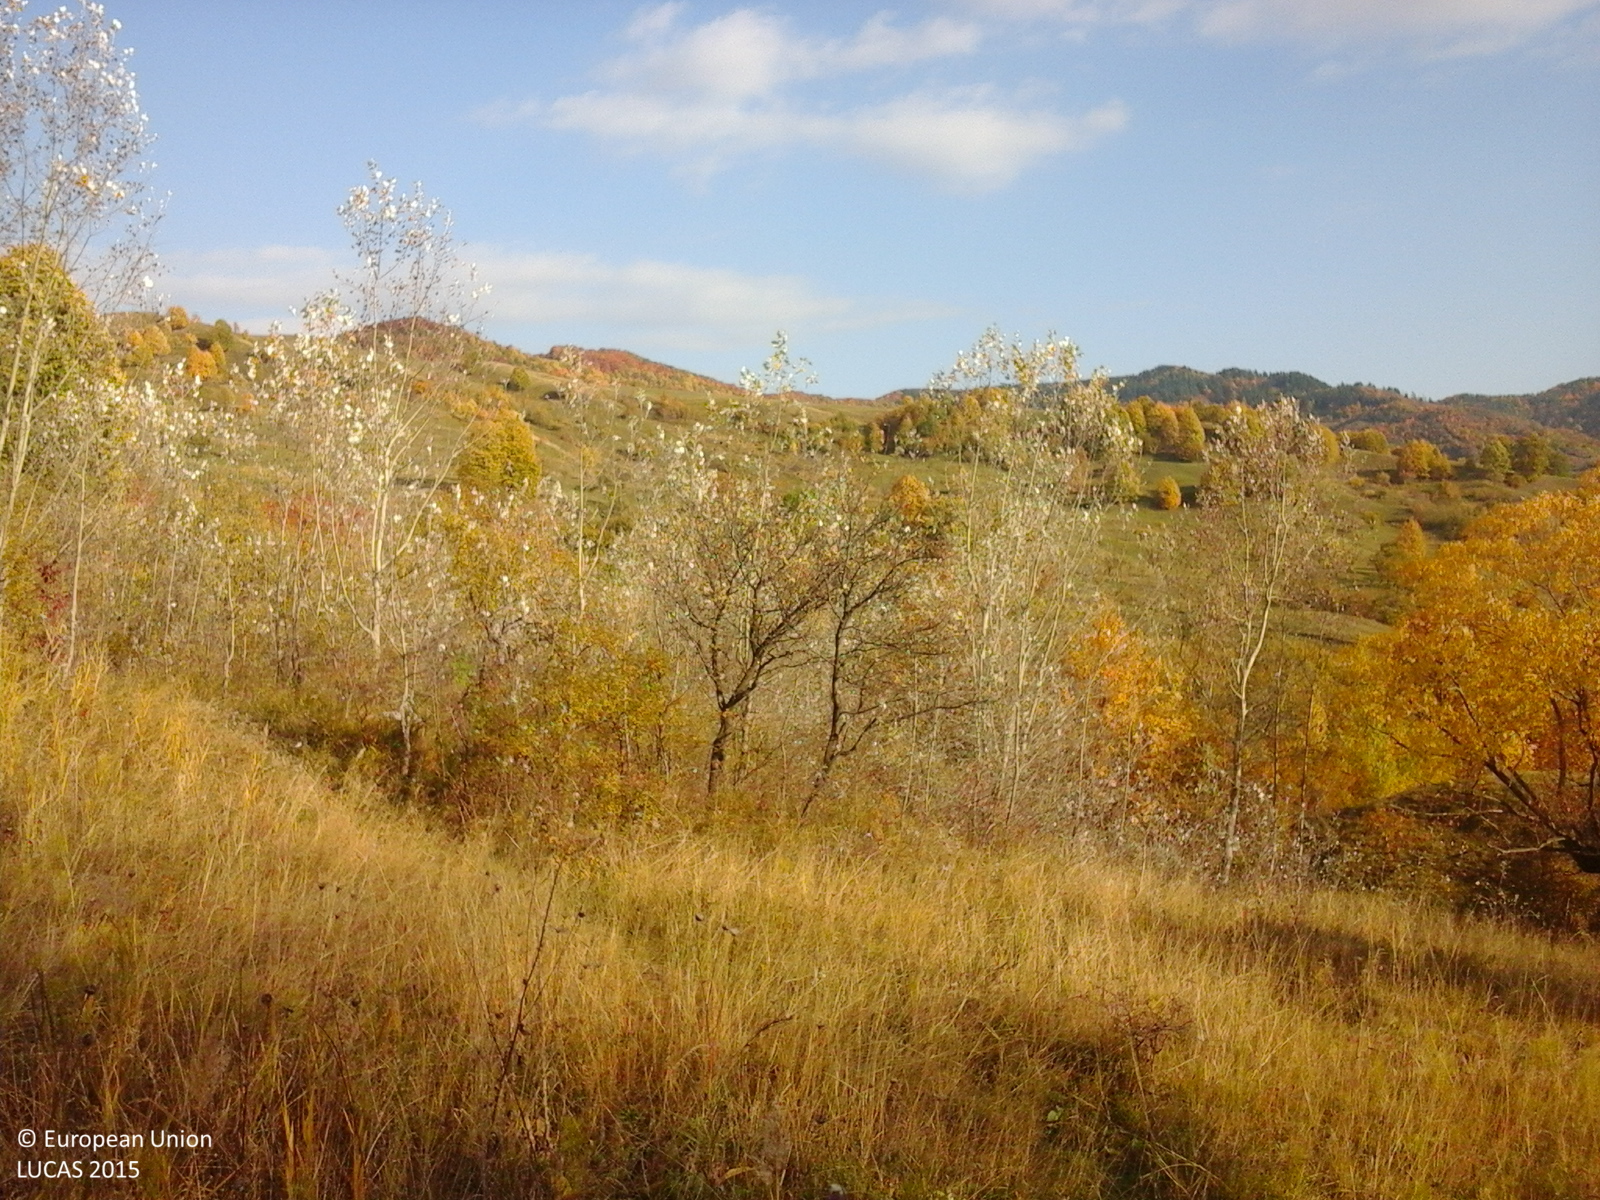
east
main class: Grassland
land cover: Grassland with sparse tree/shrub cover
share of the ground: > 75 %
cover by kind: herbaceous plants 85 %, shrubs 10 %, broadleaved forest trees 5 %
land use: Agriculture (excluding fallow land and kitchen gardens)
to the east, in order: Grassland with sparse tree/shrub cover; Broadleaved woodland; Other fruit trees and berries; Artificial constructions in urban areas; Grassland without tree/shrub cover; Tracks; Grassland with sparse tree/shrub cover; Fences; Spontaneously vegetated surfaces; Abandoned hedges
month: October
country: RO
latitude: 45.4629
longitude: 26.6135
